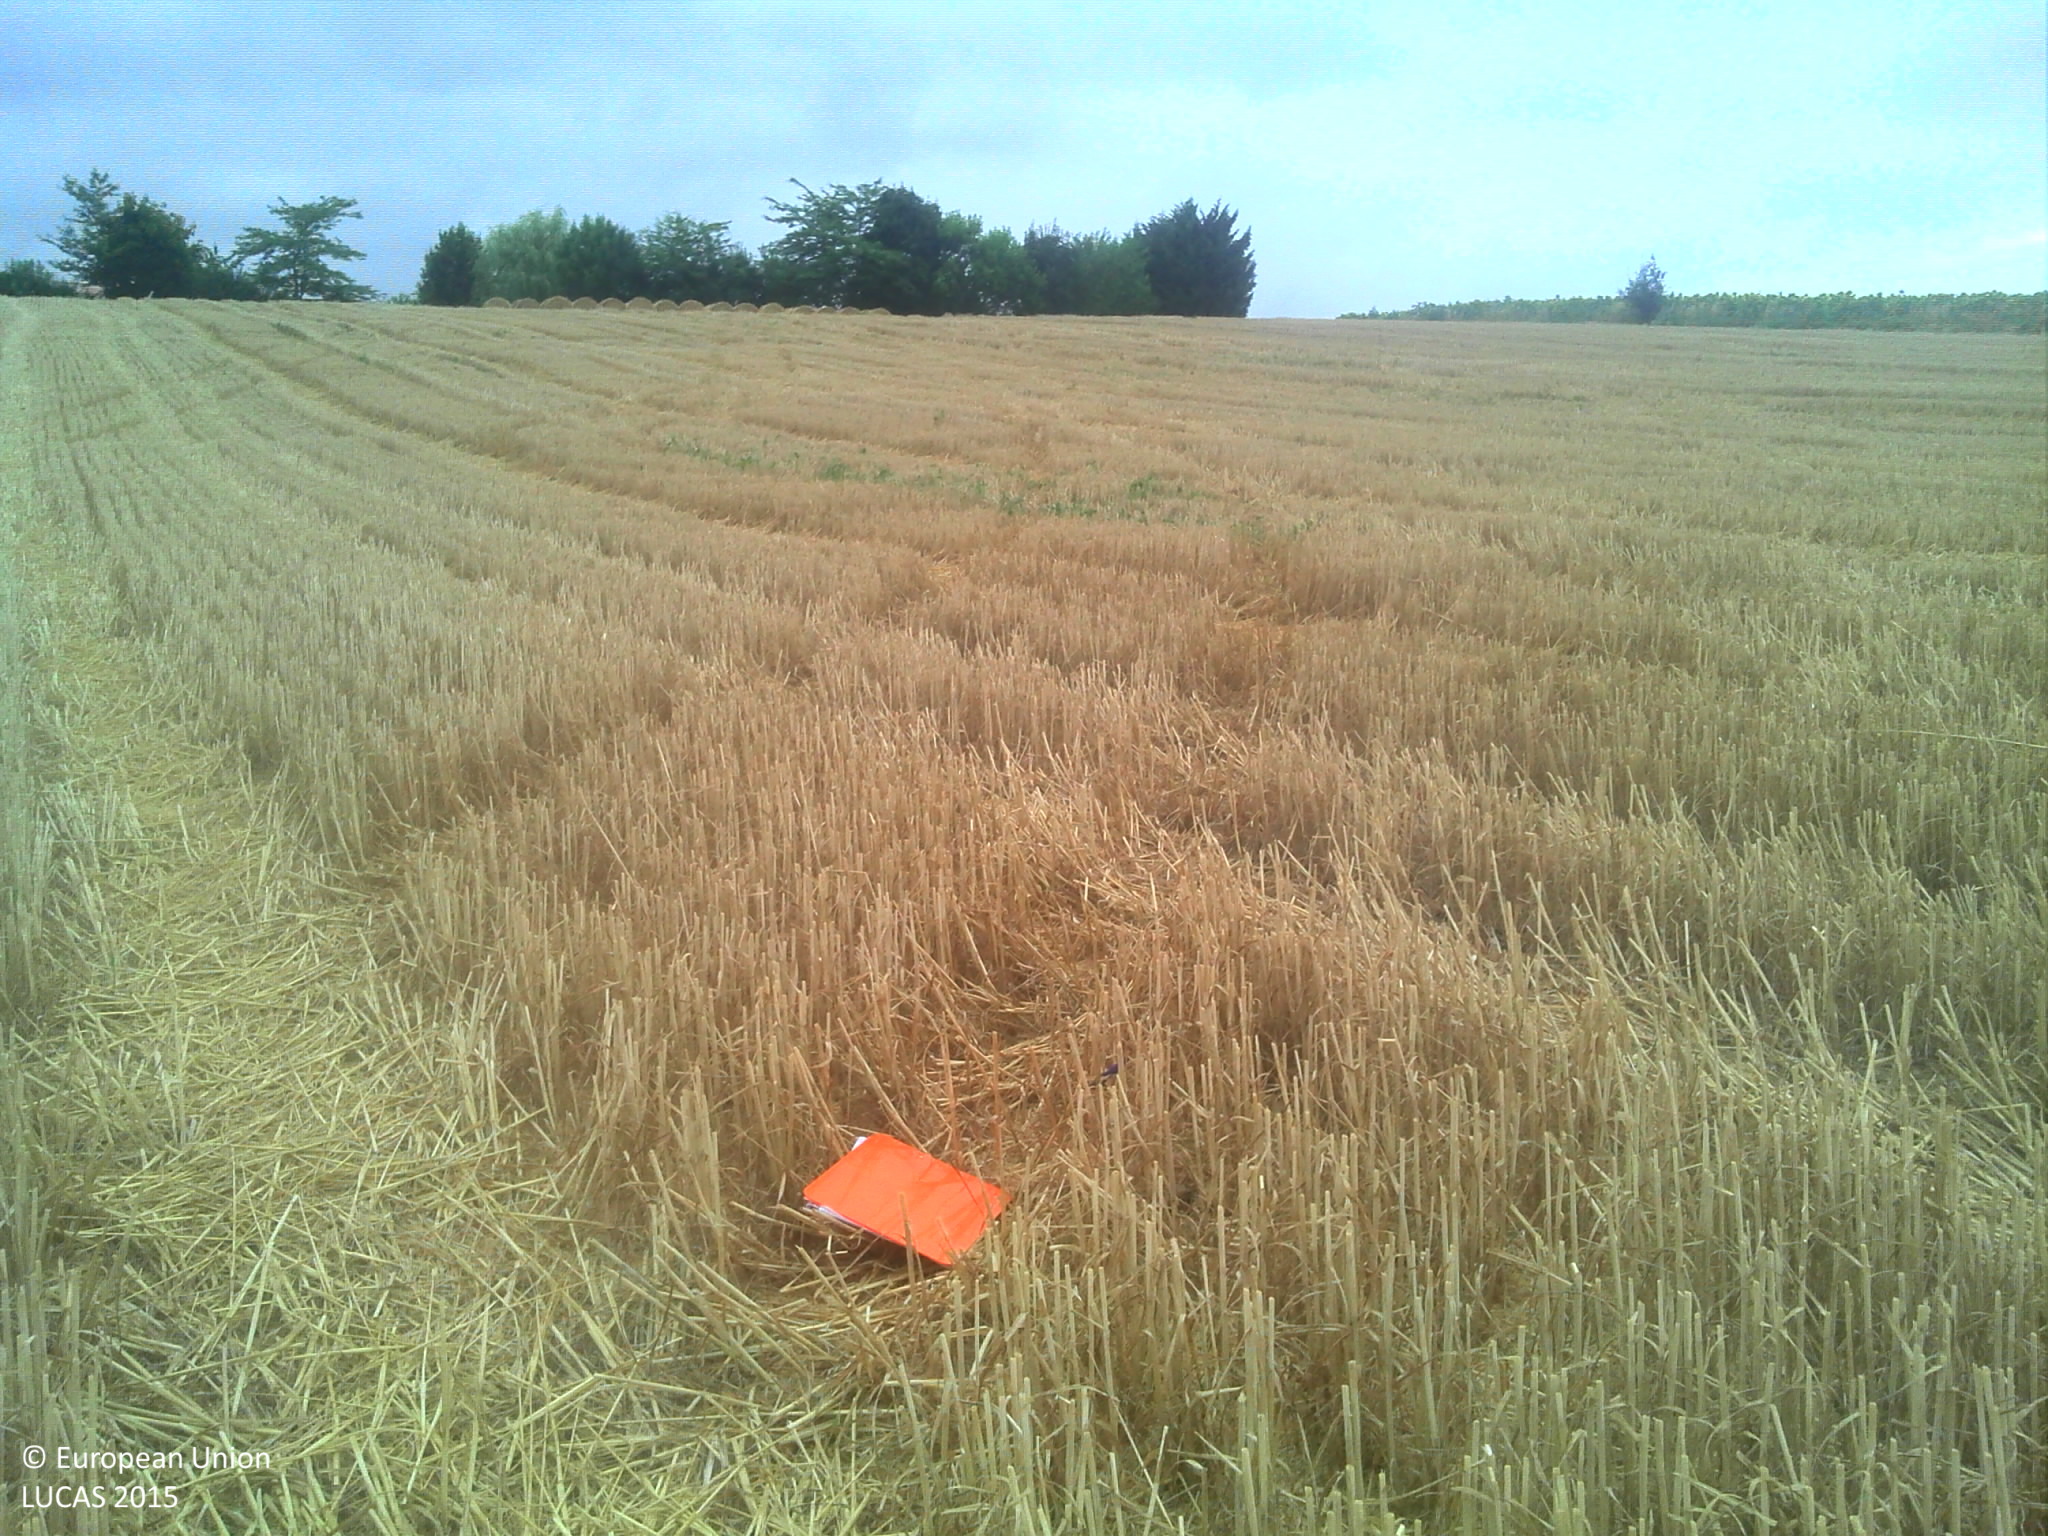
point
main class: Cropland
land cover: Common wheat
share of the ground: > 75 %
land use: Agriculture (excluding fallow land and kitchen gardens)
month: July
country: FR
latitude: 43.2332
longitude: 1.4221
